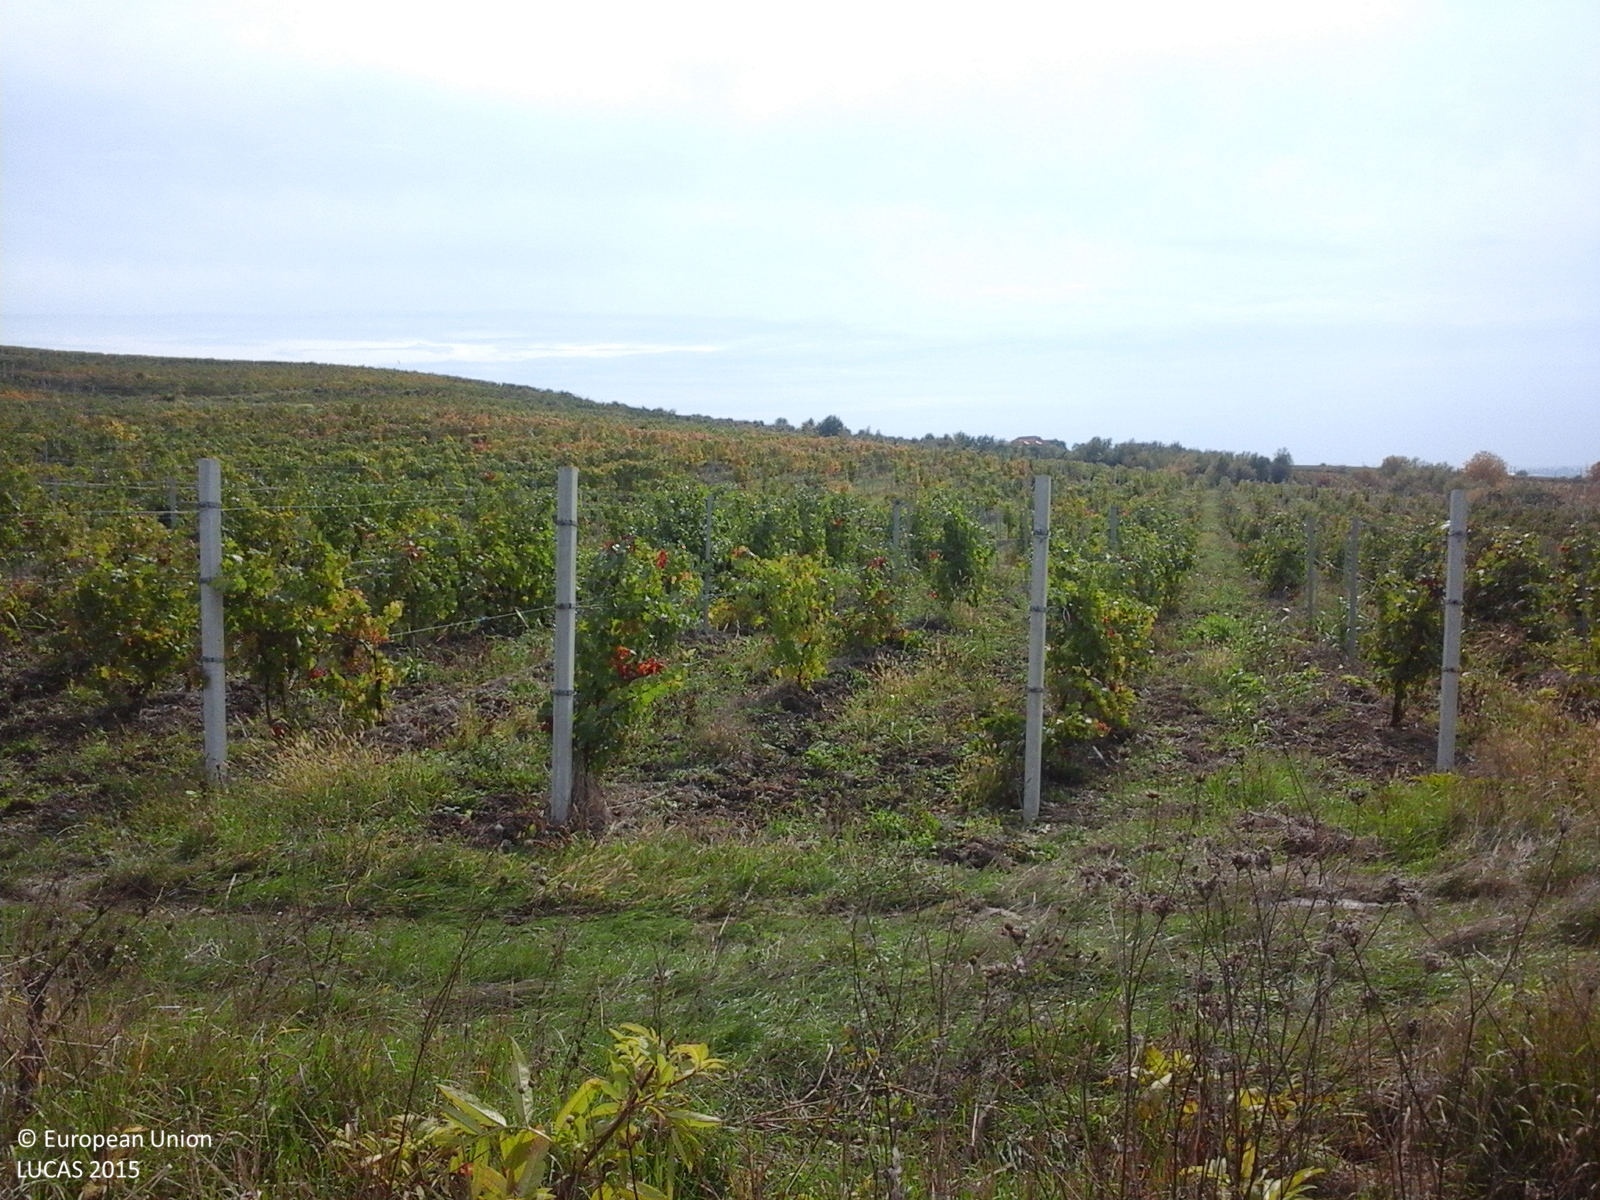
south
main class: Grassland
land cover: Grassland with sparse tree/shrub cover
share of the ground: > 75 %
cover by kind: herbaceous plants 85 %, shrubs 10 %, broadleaved forest trees 5 %
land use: Fallow land
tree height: < 5 m
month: October
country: RO
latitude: 44.9921
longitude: 26.1054
